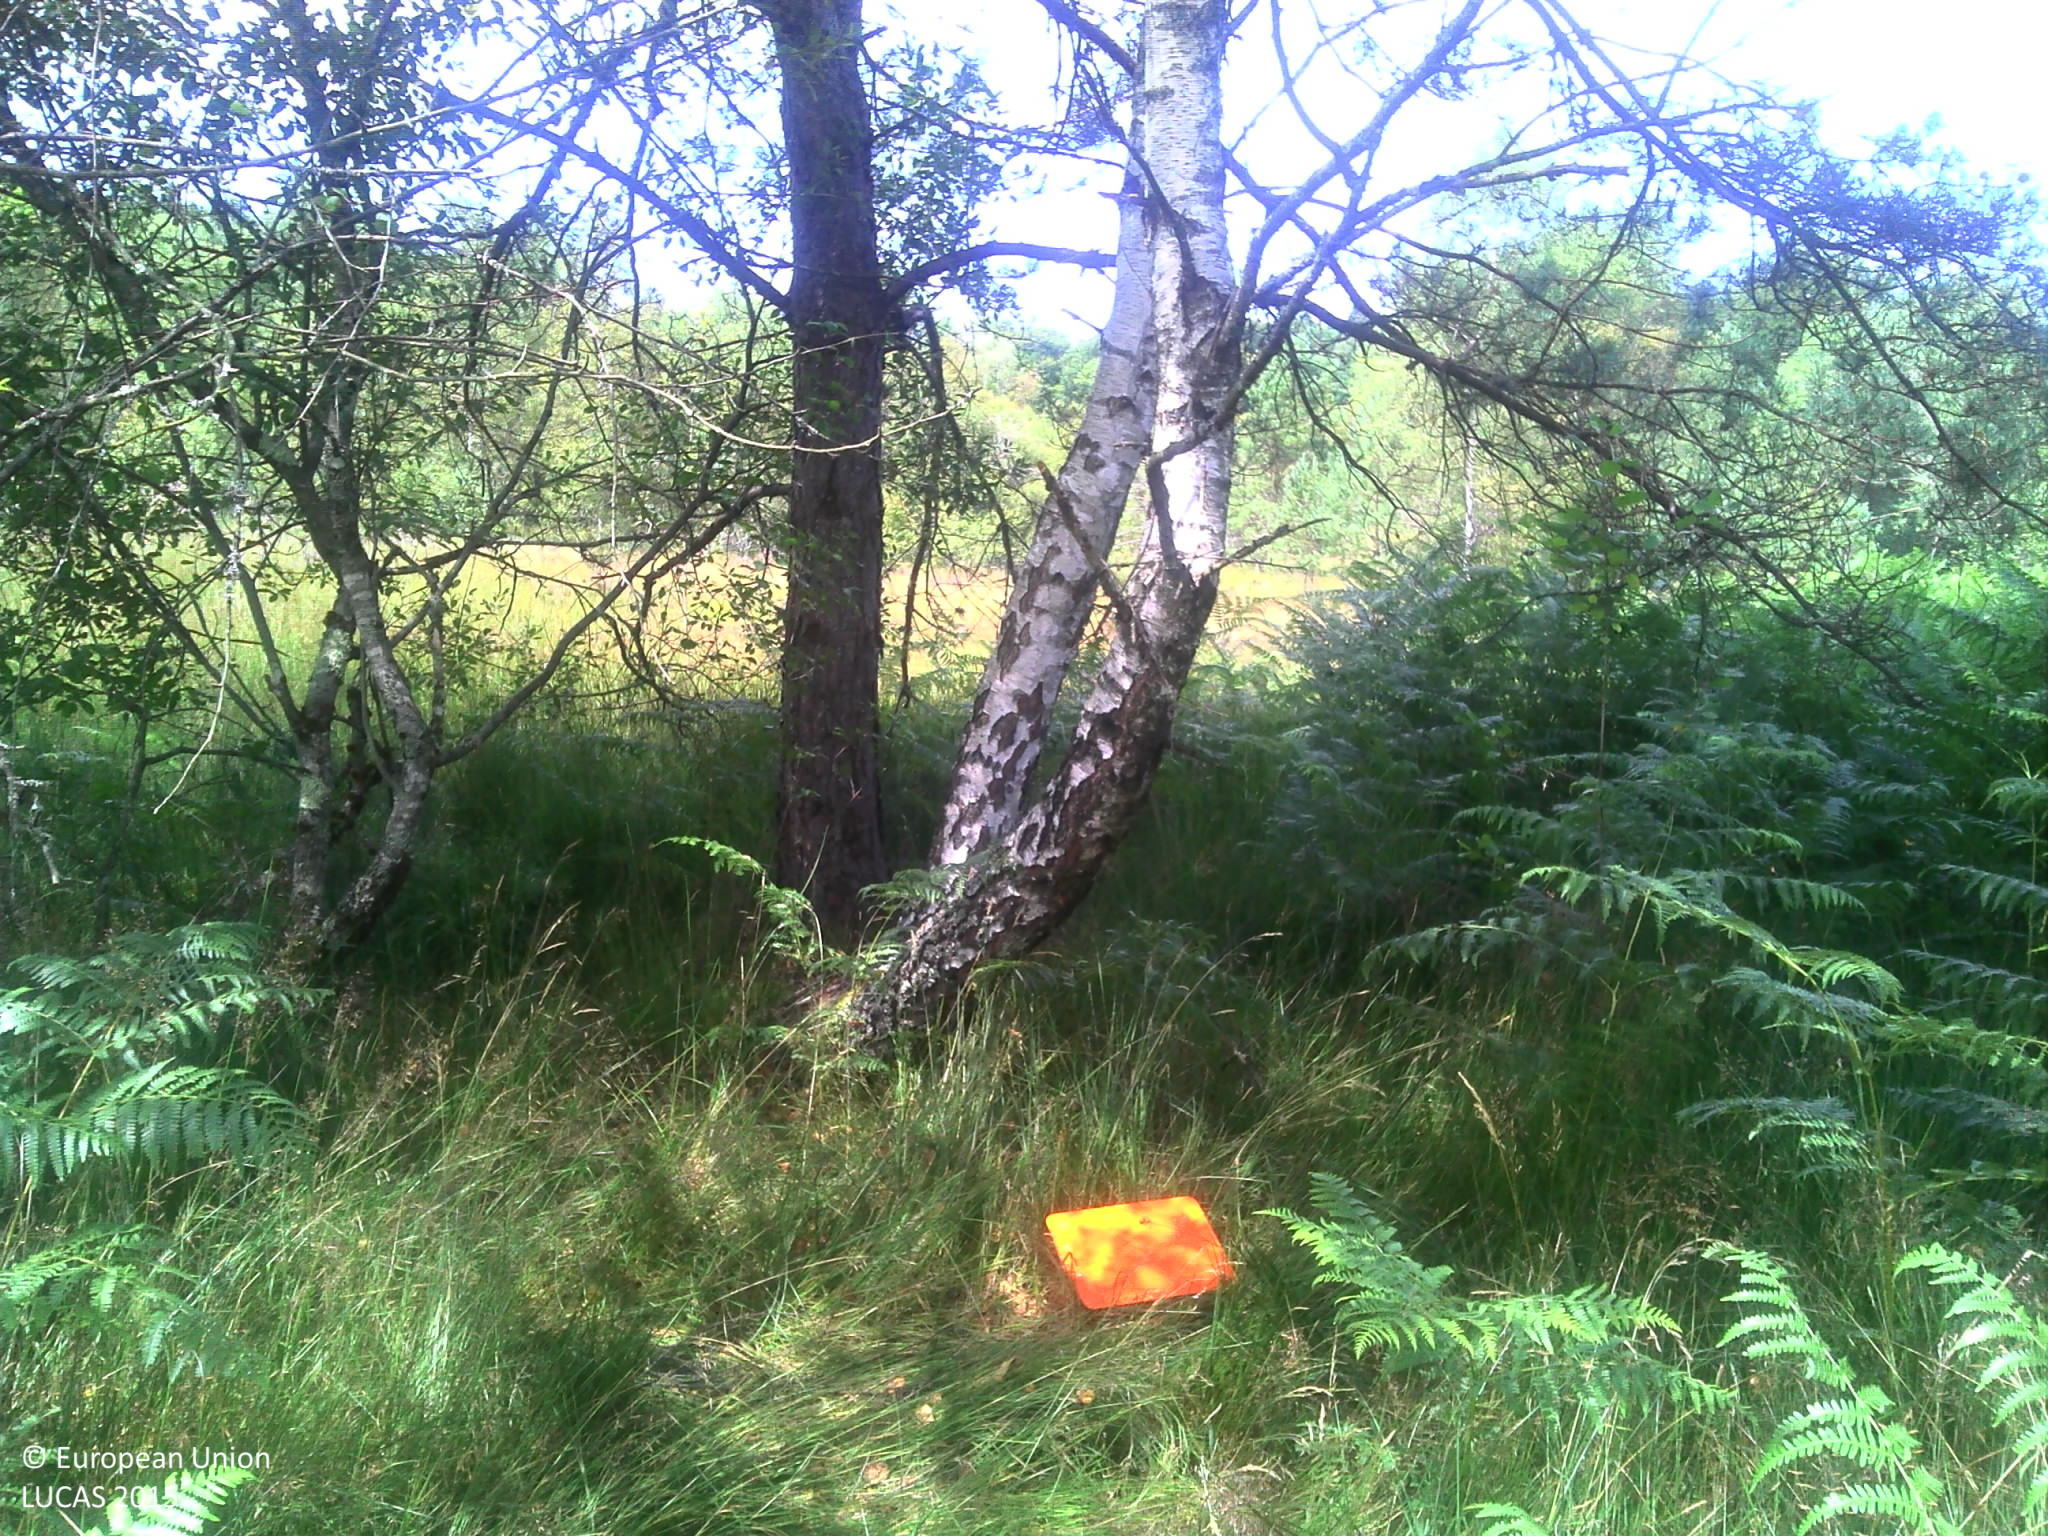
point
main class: Woodland
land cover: Broadleaved woodland
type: non-riverine alder, birch or aspen forest
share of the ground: > 75 %
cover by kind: shrubs 45 %, broadleaved forest trees 35 %, herbaceous plants 20 %
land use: Semi-natural and natural areas not in use
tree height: > 5 m
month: July
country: FR
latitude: 45.6236
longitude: 1.8507
